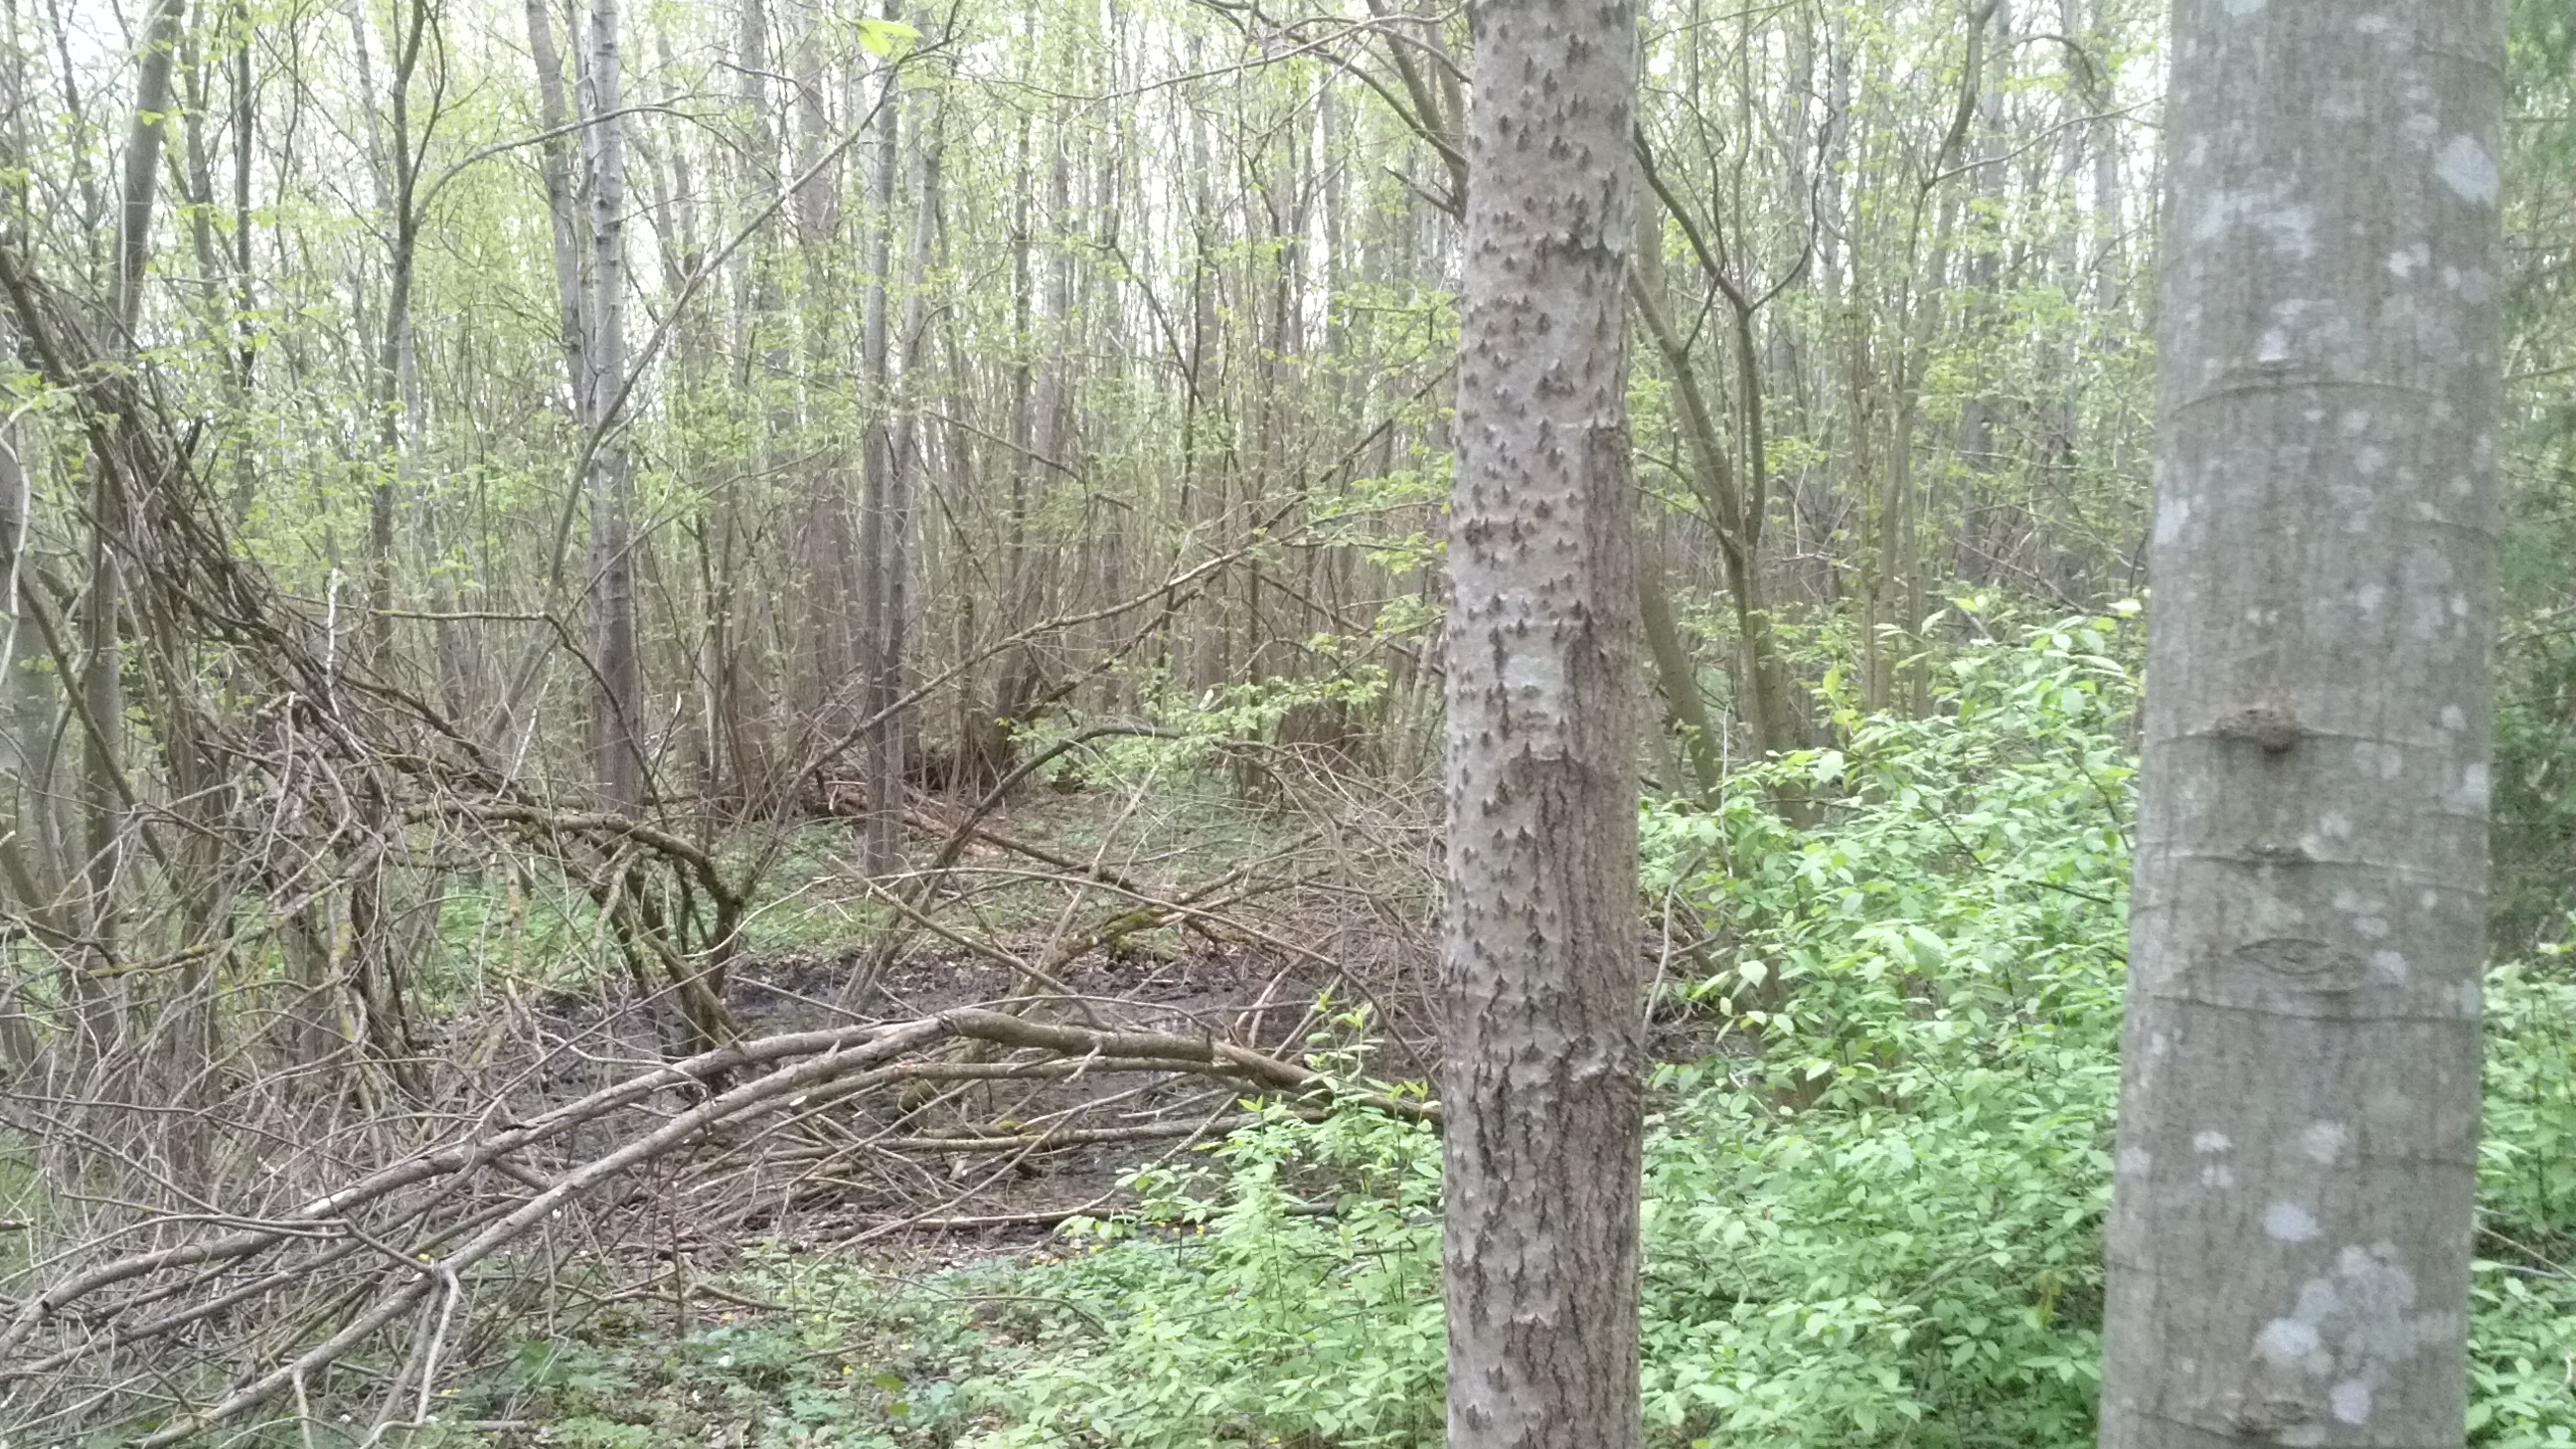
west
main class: Woodland
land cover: Broadleaved woodland
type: non-riverine alder, birch or aspen forest
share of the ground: > 75 %
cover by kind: broadleaved forest trees 90 %, coniferous forest trees 10 %
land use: Forestry
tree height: > 5 m
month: May
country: LV
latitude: 55.9838
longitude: 27.1106
